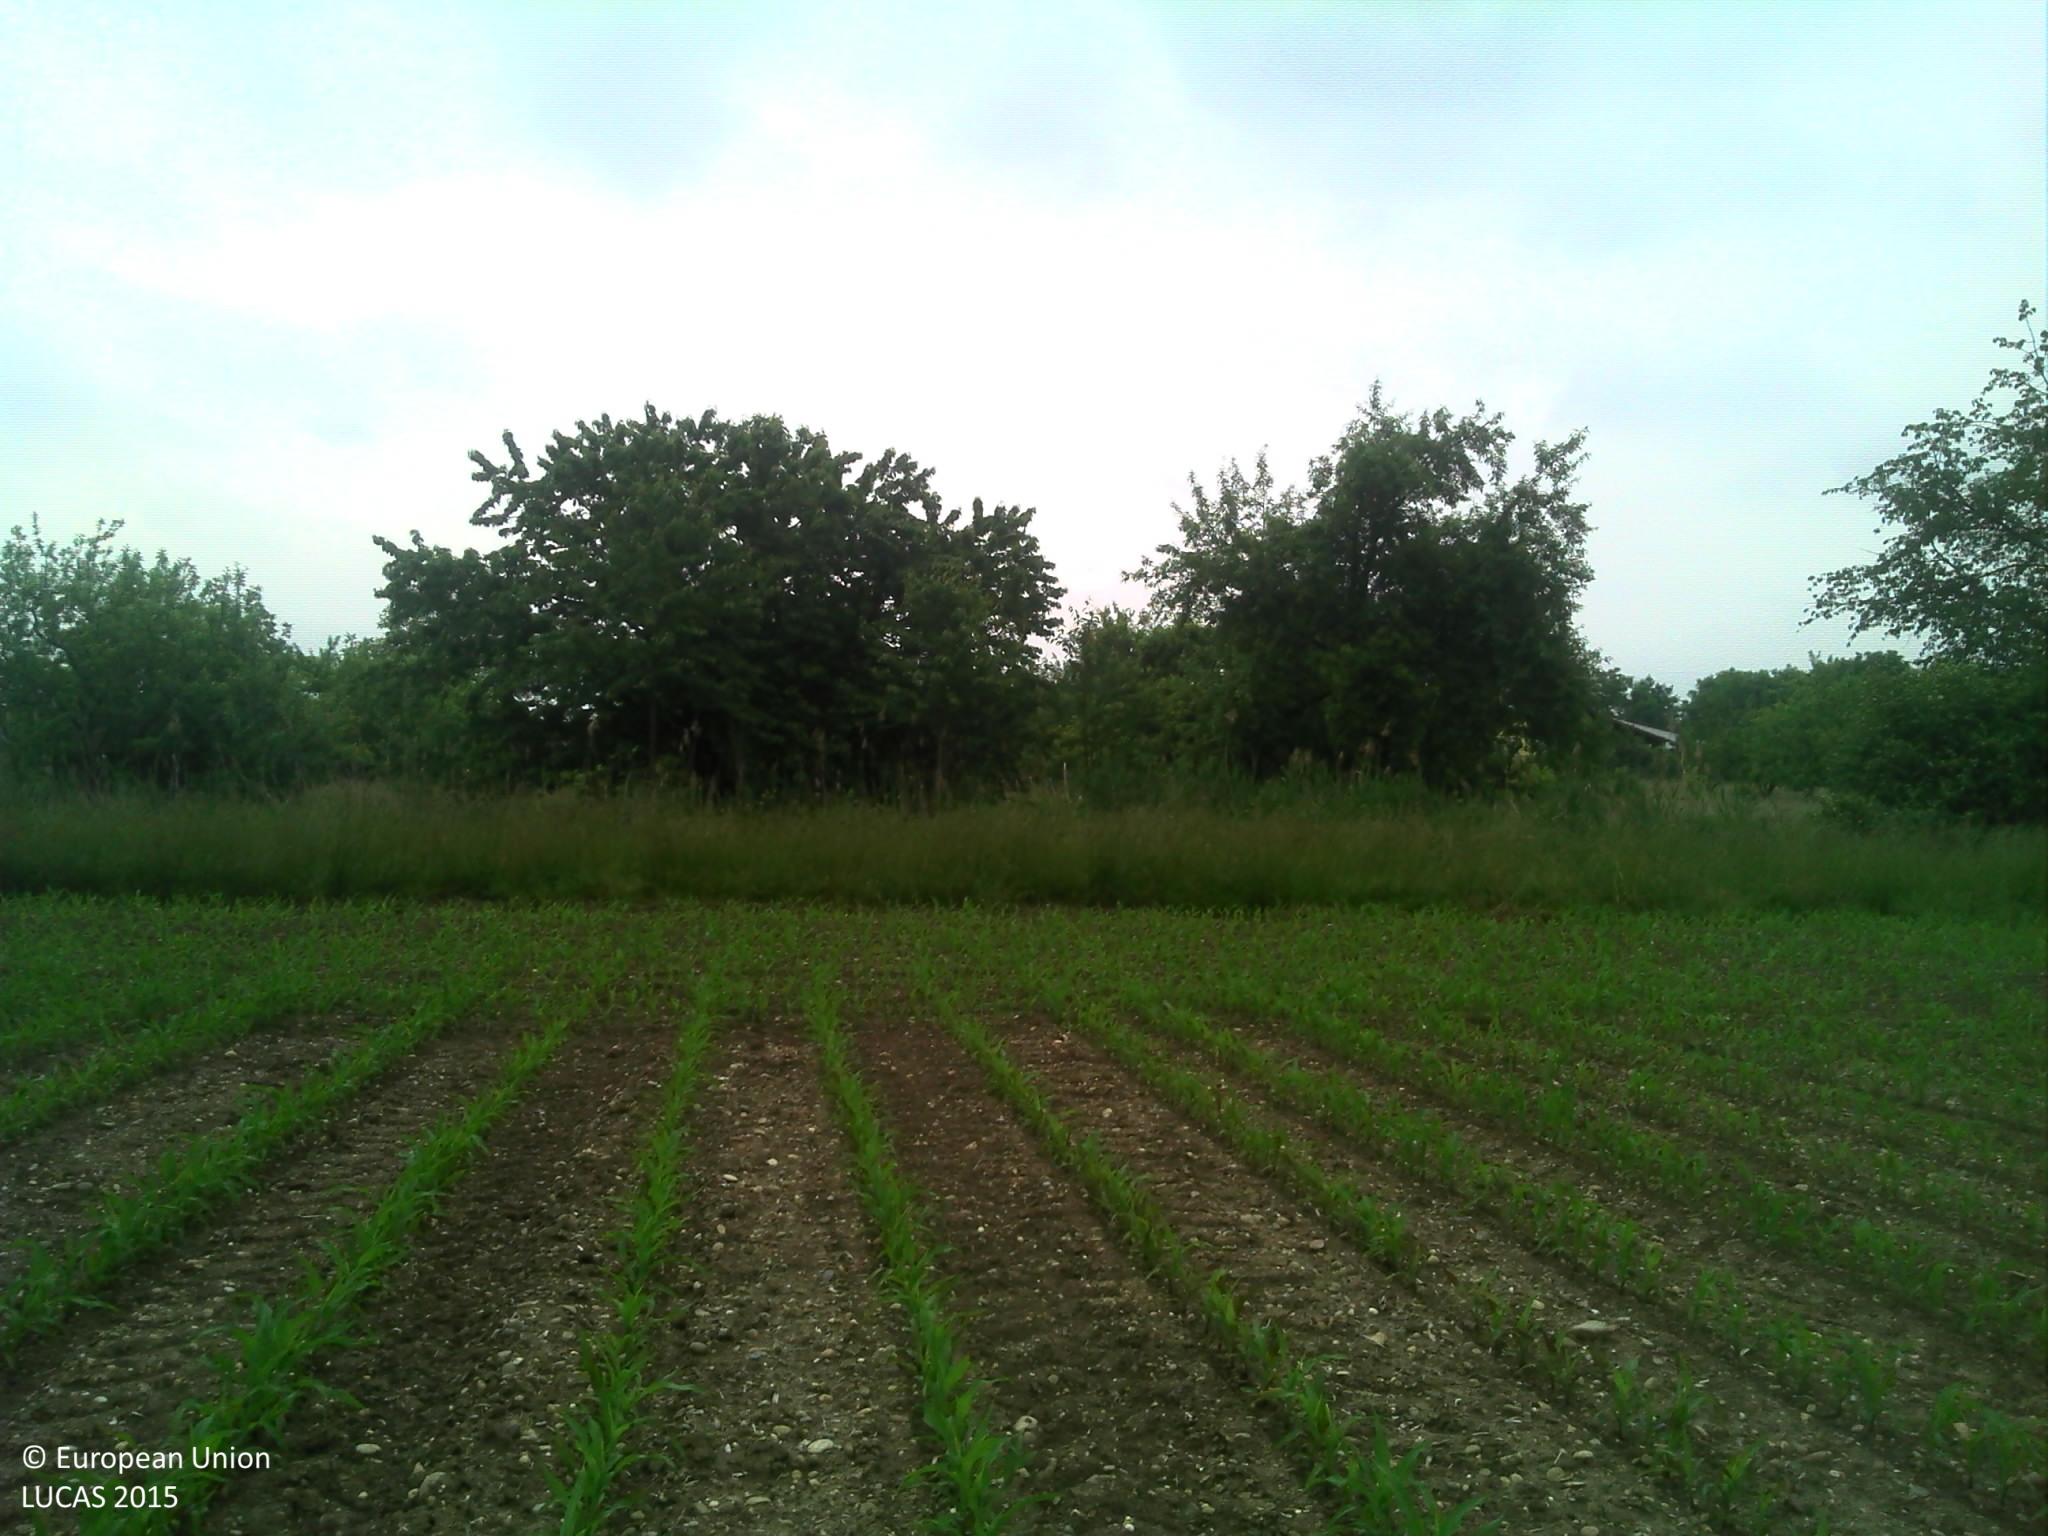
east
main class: Cropland
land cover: Maize
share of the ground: > 75 %
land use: Agriculture (excluding fallow land and kitchen gardens)
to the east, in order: Maize; Grass margins; Shrubland with sparse tree cover; Rivers and streams; Cherry fruit; Apple fruit; Nuts trees; Fences; Grass margins; Tracks; Grassland without tree/shrub cover; Fences; Grassland without tree/shrub cover; Fences; Grass margins; Durum wheat
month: May
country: FR
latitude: 48.2692
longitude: 7.5894
